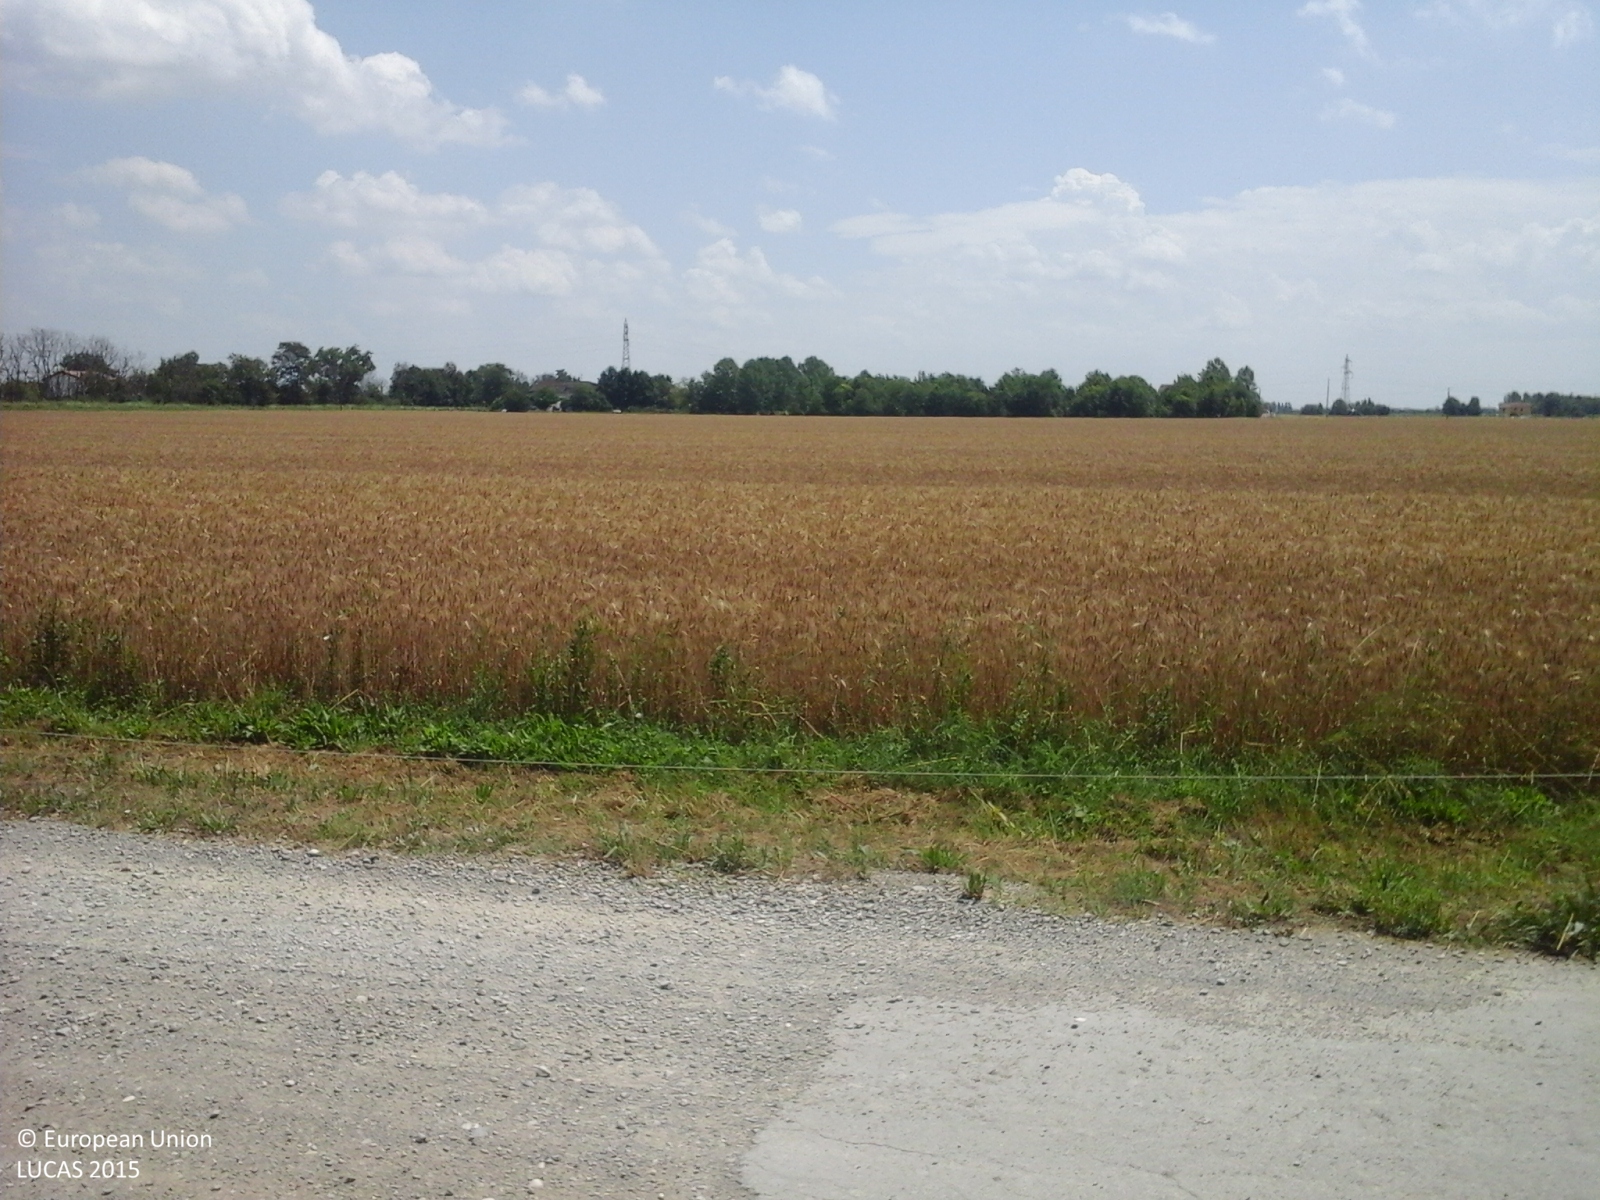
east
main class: Woodland
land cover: Broadleaved woodland
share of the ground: > 75 %
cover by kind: broadleaved forest trees 100 %
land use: Residential
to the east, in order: Broadleaved woodland; Artificial constructions in urban areas; Broadleaved woodland; Fences; Ditches and canals; Paved roads, cycling and walking lanes; Ditches and canals; Electric lines; Common wheat; Ditches and canals; Common wheat; Ditches and canals; Common wheat; Ditches and canals; Common wheat; Ditches and canals; Common wheat; Ditches and canals; Common wheat; Ditches and canals; Common wheat; Ditches and canals
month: June
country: IT
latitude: 44.8137
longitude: 11.0979
